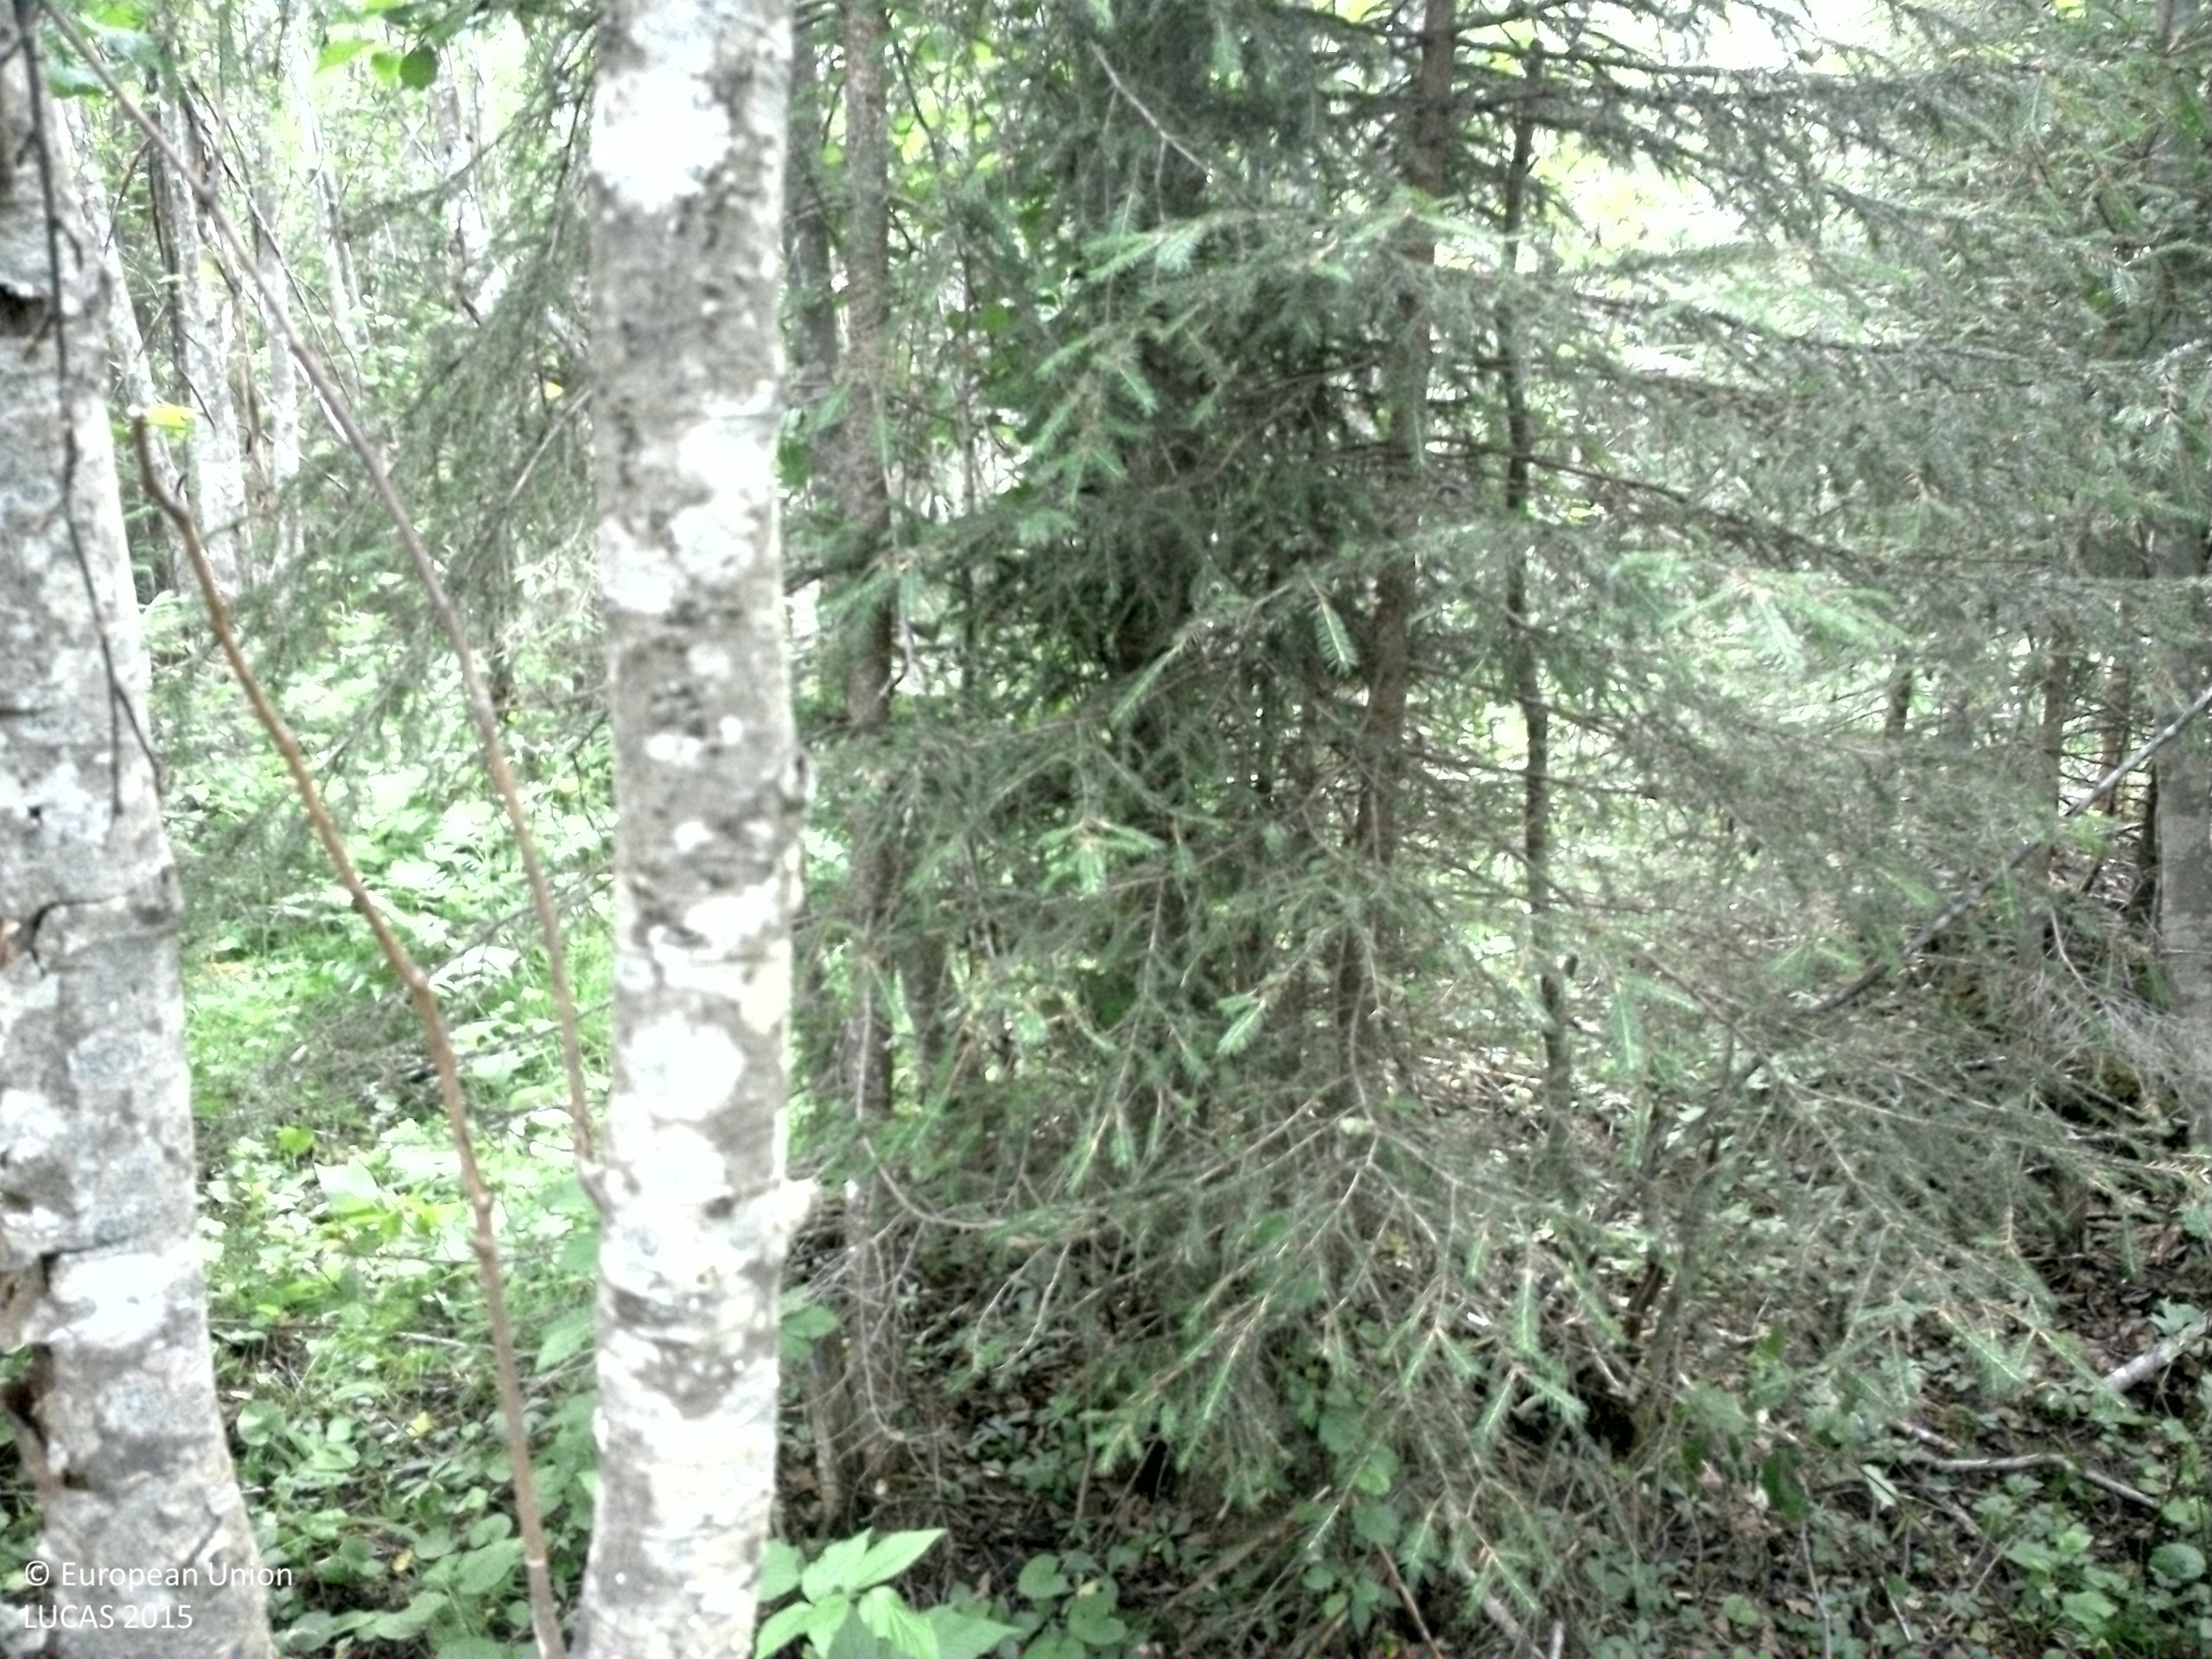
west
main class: Woodland
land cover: Spruce dominated mixed woodland
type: boreal forest
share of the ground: > 75 %
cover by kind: broadleaved forest trees 45 %, coniferous forest trees 40 %, herbaceous plants 10 %
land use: Forestry
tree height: > 5 m
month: August
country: SE
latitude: 63.7141
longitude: 16.6717
